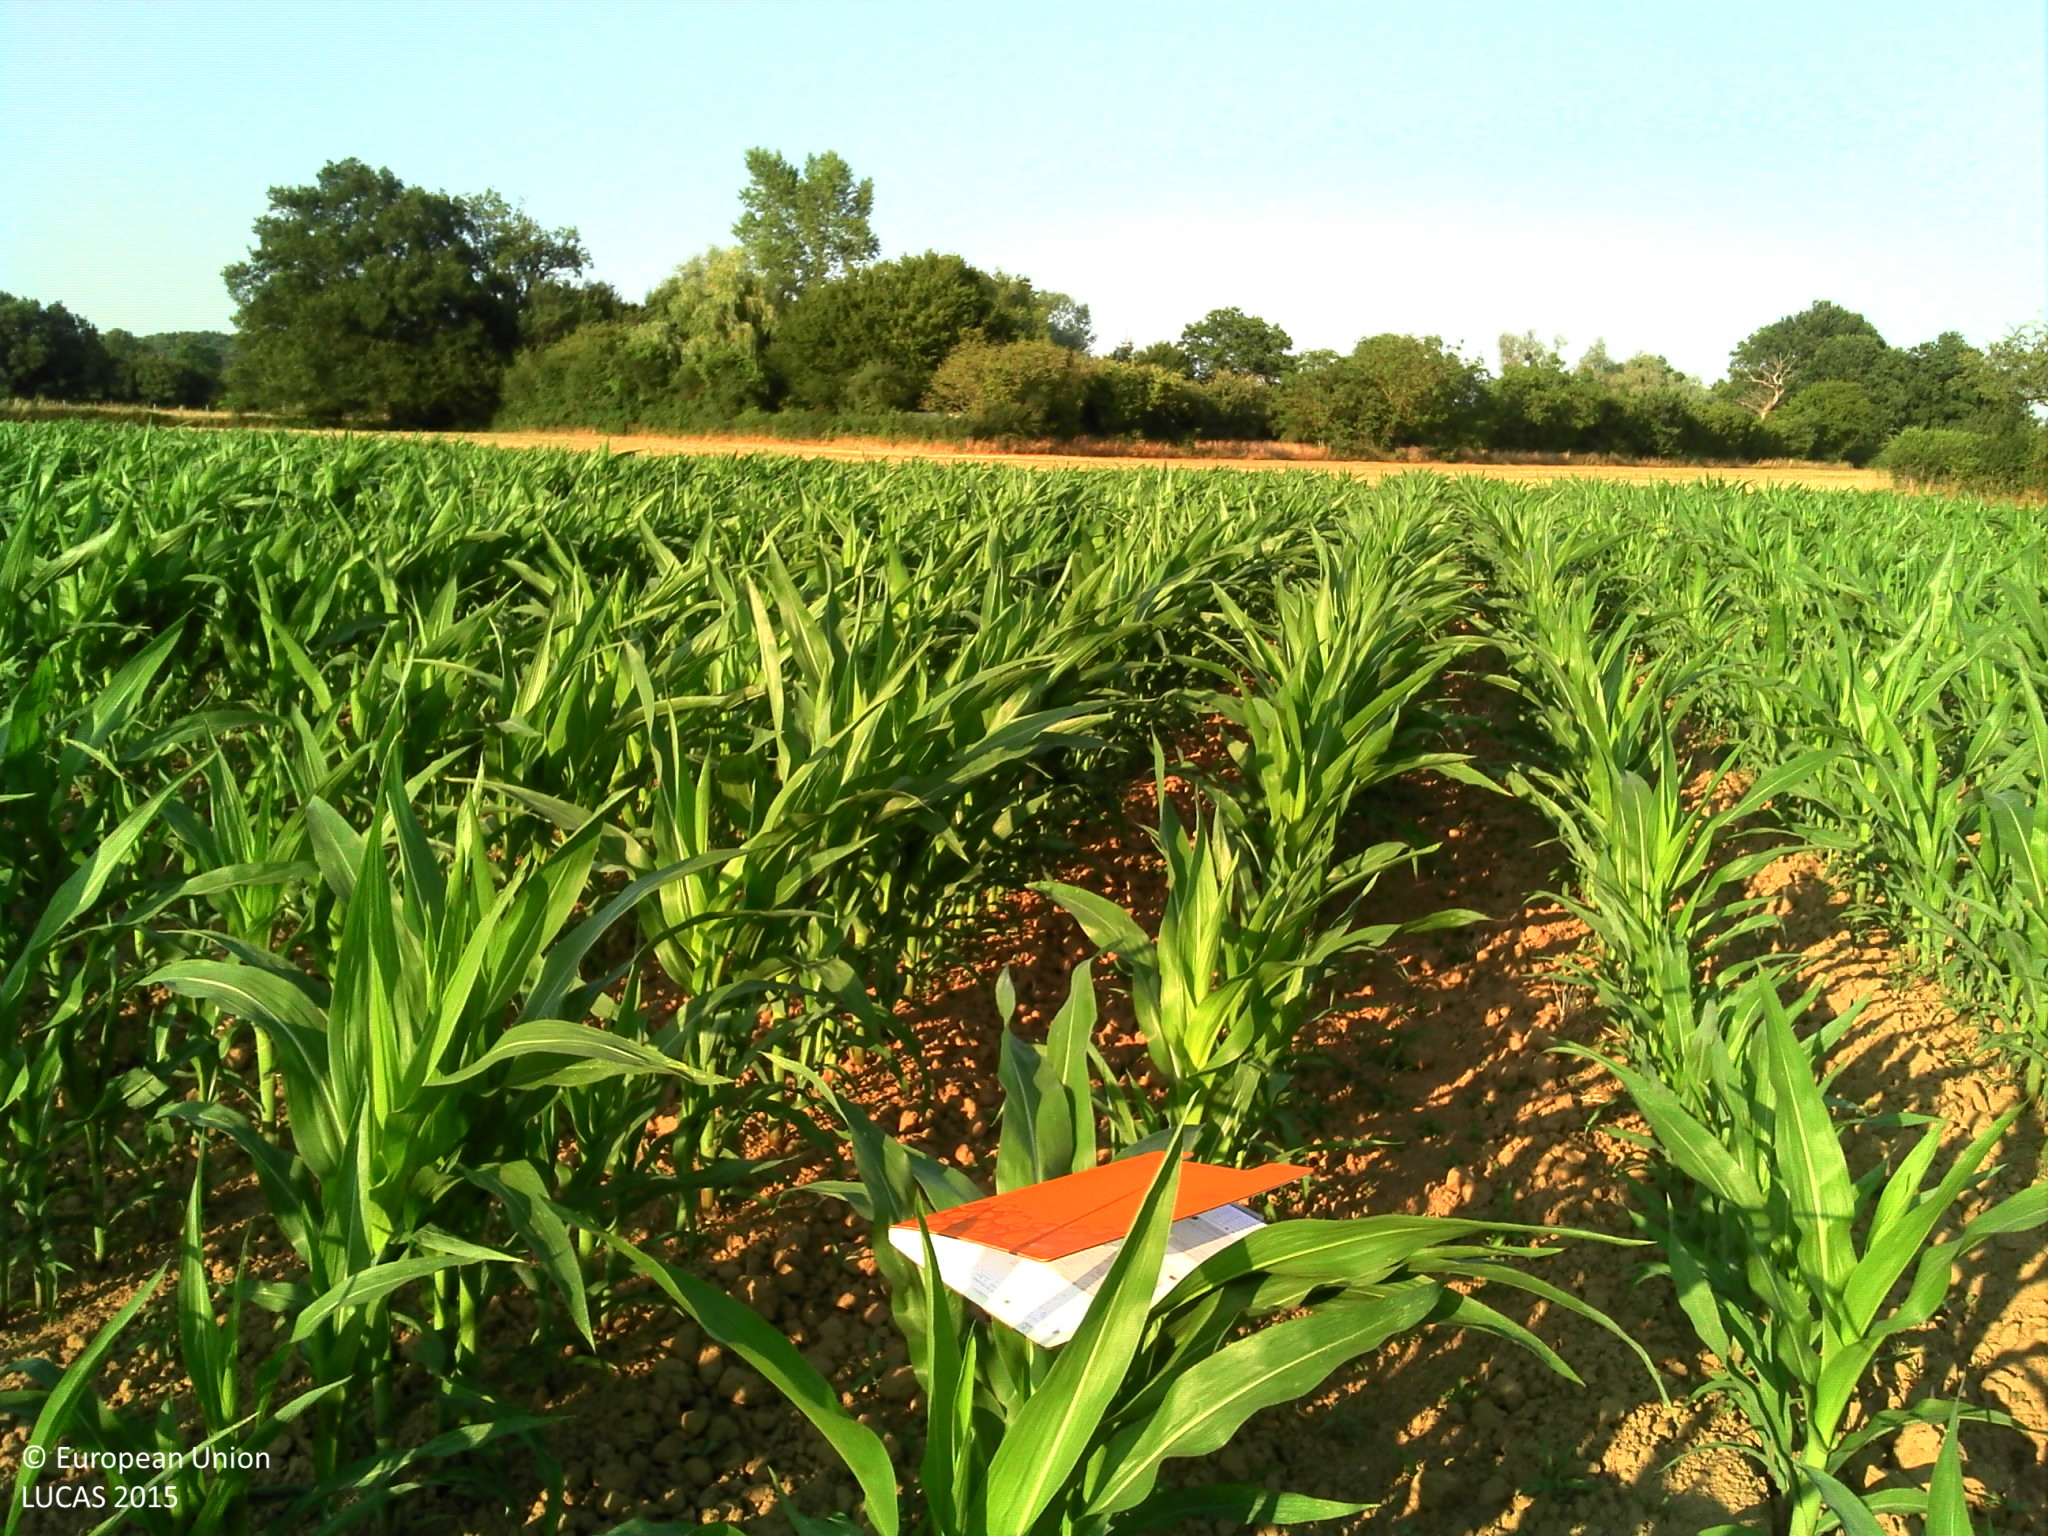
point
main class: Cropland
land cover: Maize
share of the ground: > 75 %
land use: Agriculture (excluding fallow land and kitchen gardens)
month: July
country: FR
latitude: 46.7897
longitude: 3.5662
